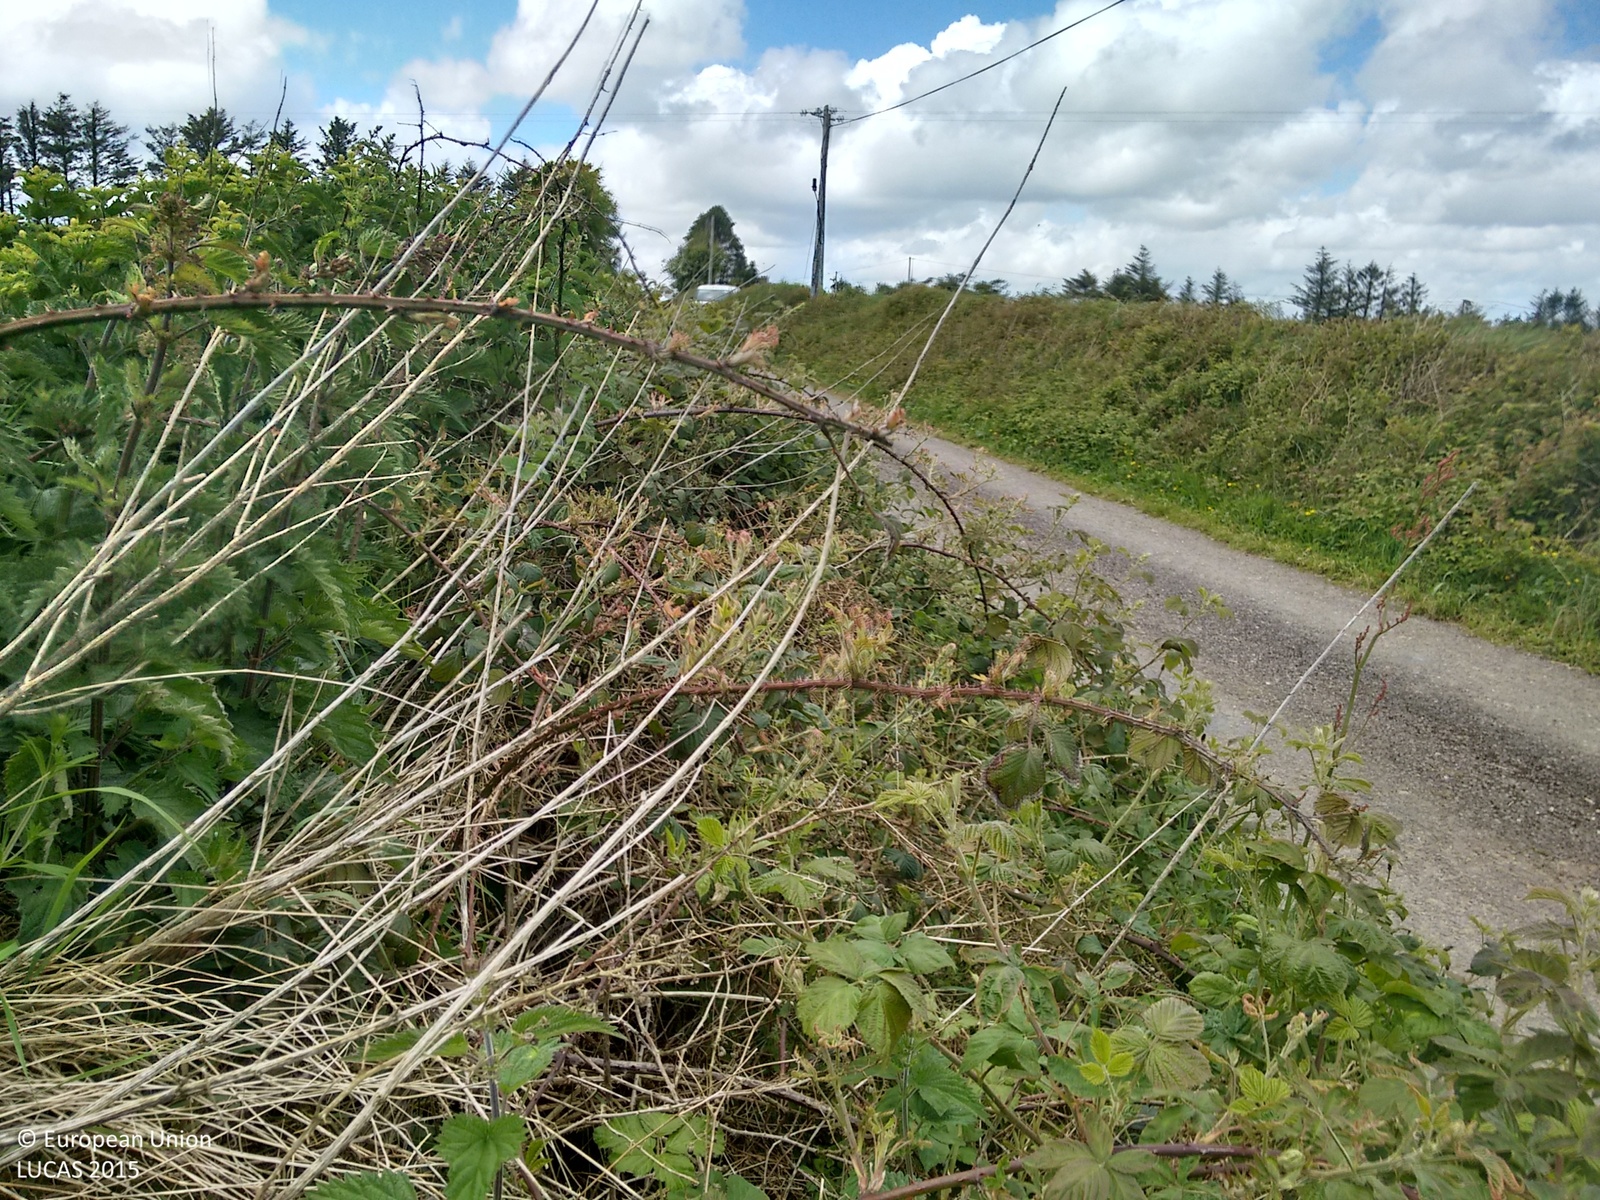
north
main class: Cropland
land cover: Barley
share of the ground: > 75 %
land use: Agriculture (excluding fallow land and kitchen gardens)
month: June
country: IE
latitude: 51.6927
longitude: -8.7647
